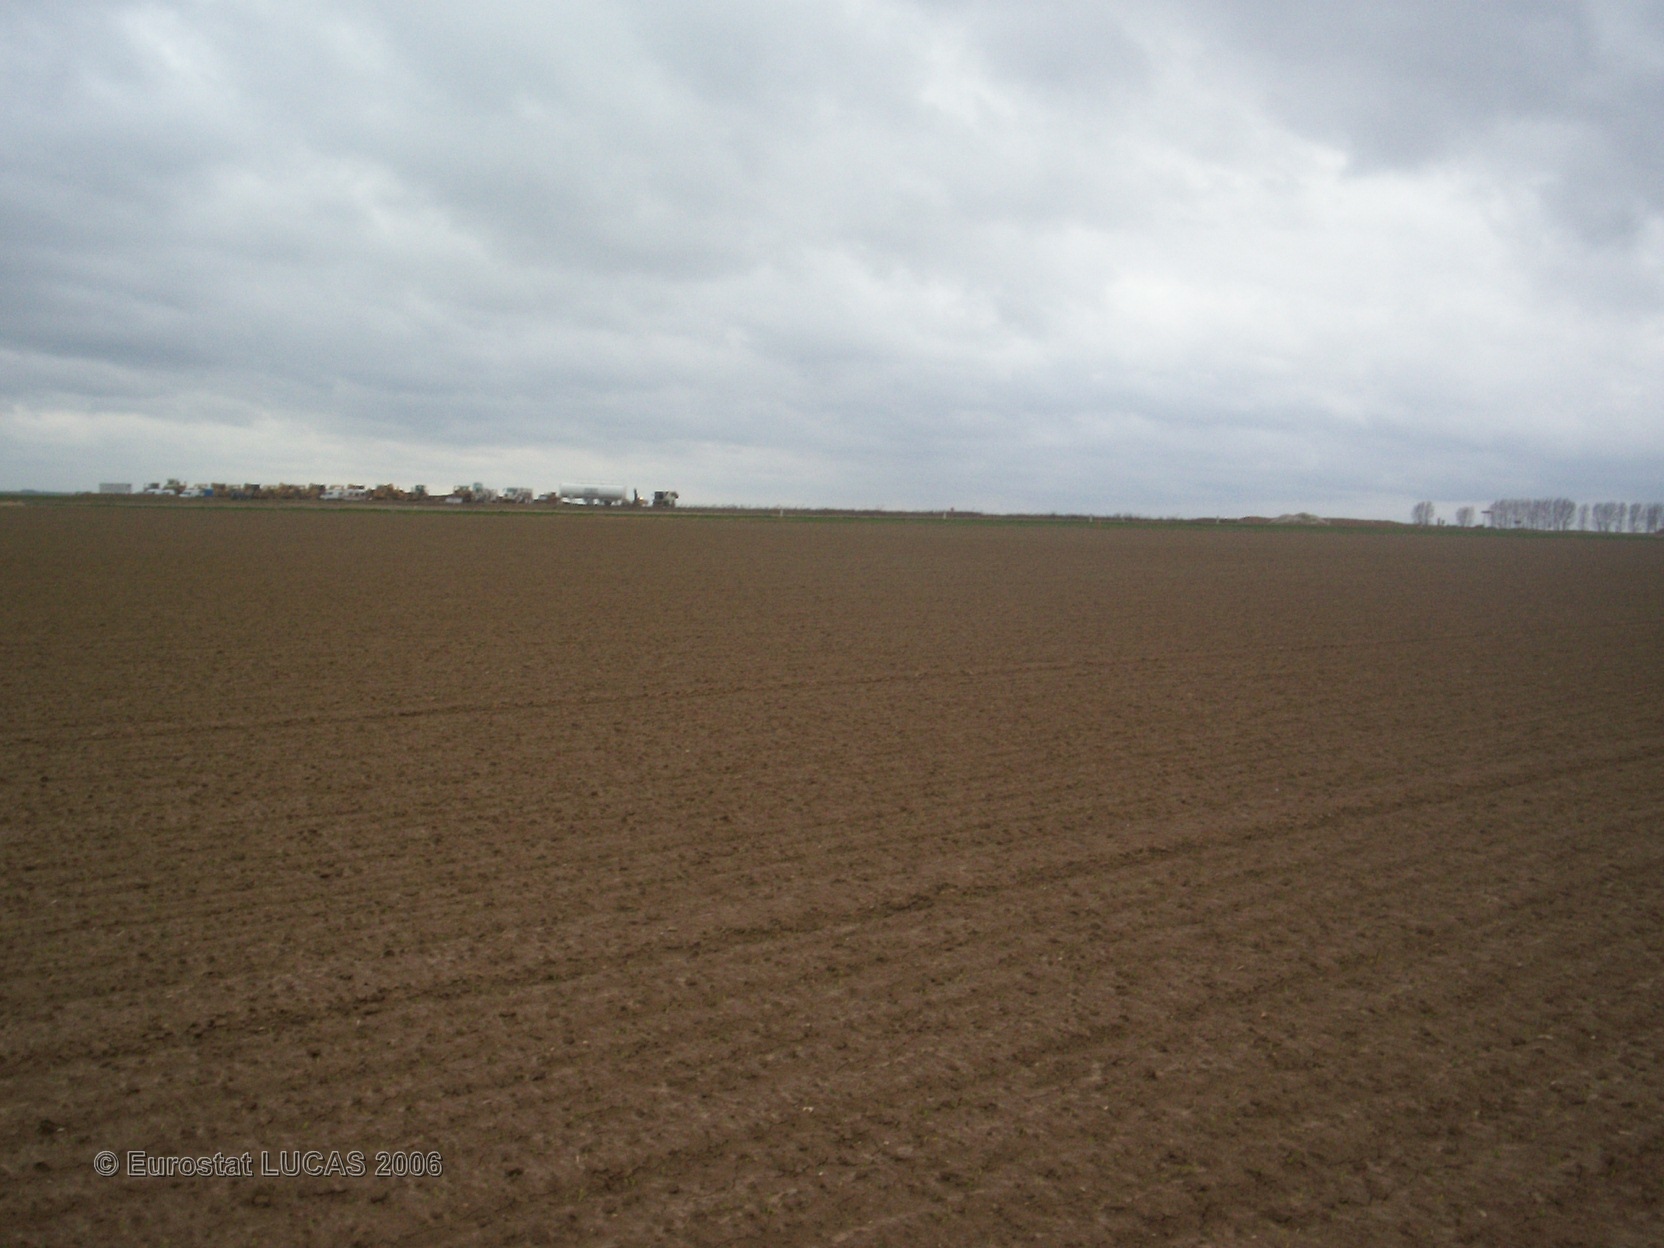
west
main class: Cropland
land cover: Maize
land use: Agriculture (excluding fallow land and kitchen gardens)
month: April
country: FR
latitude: 49.9680
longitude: 2.6971
